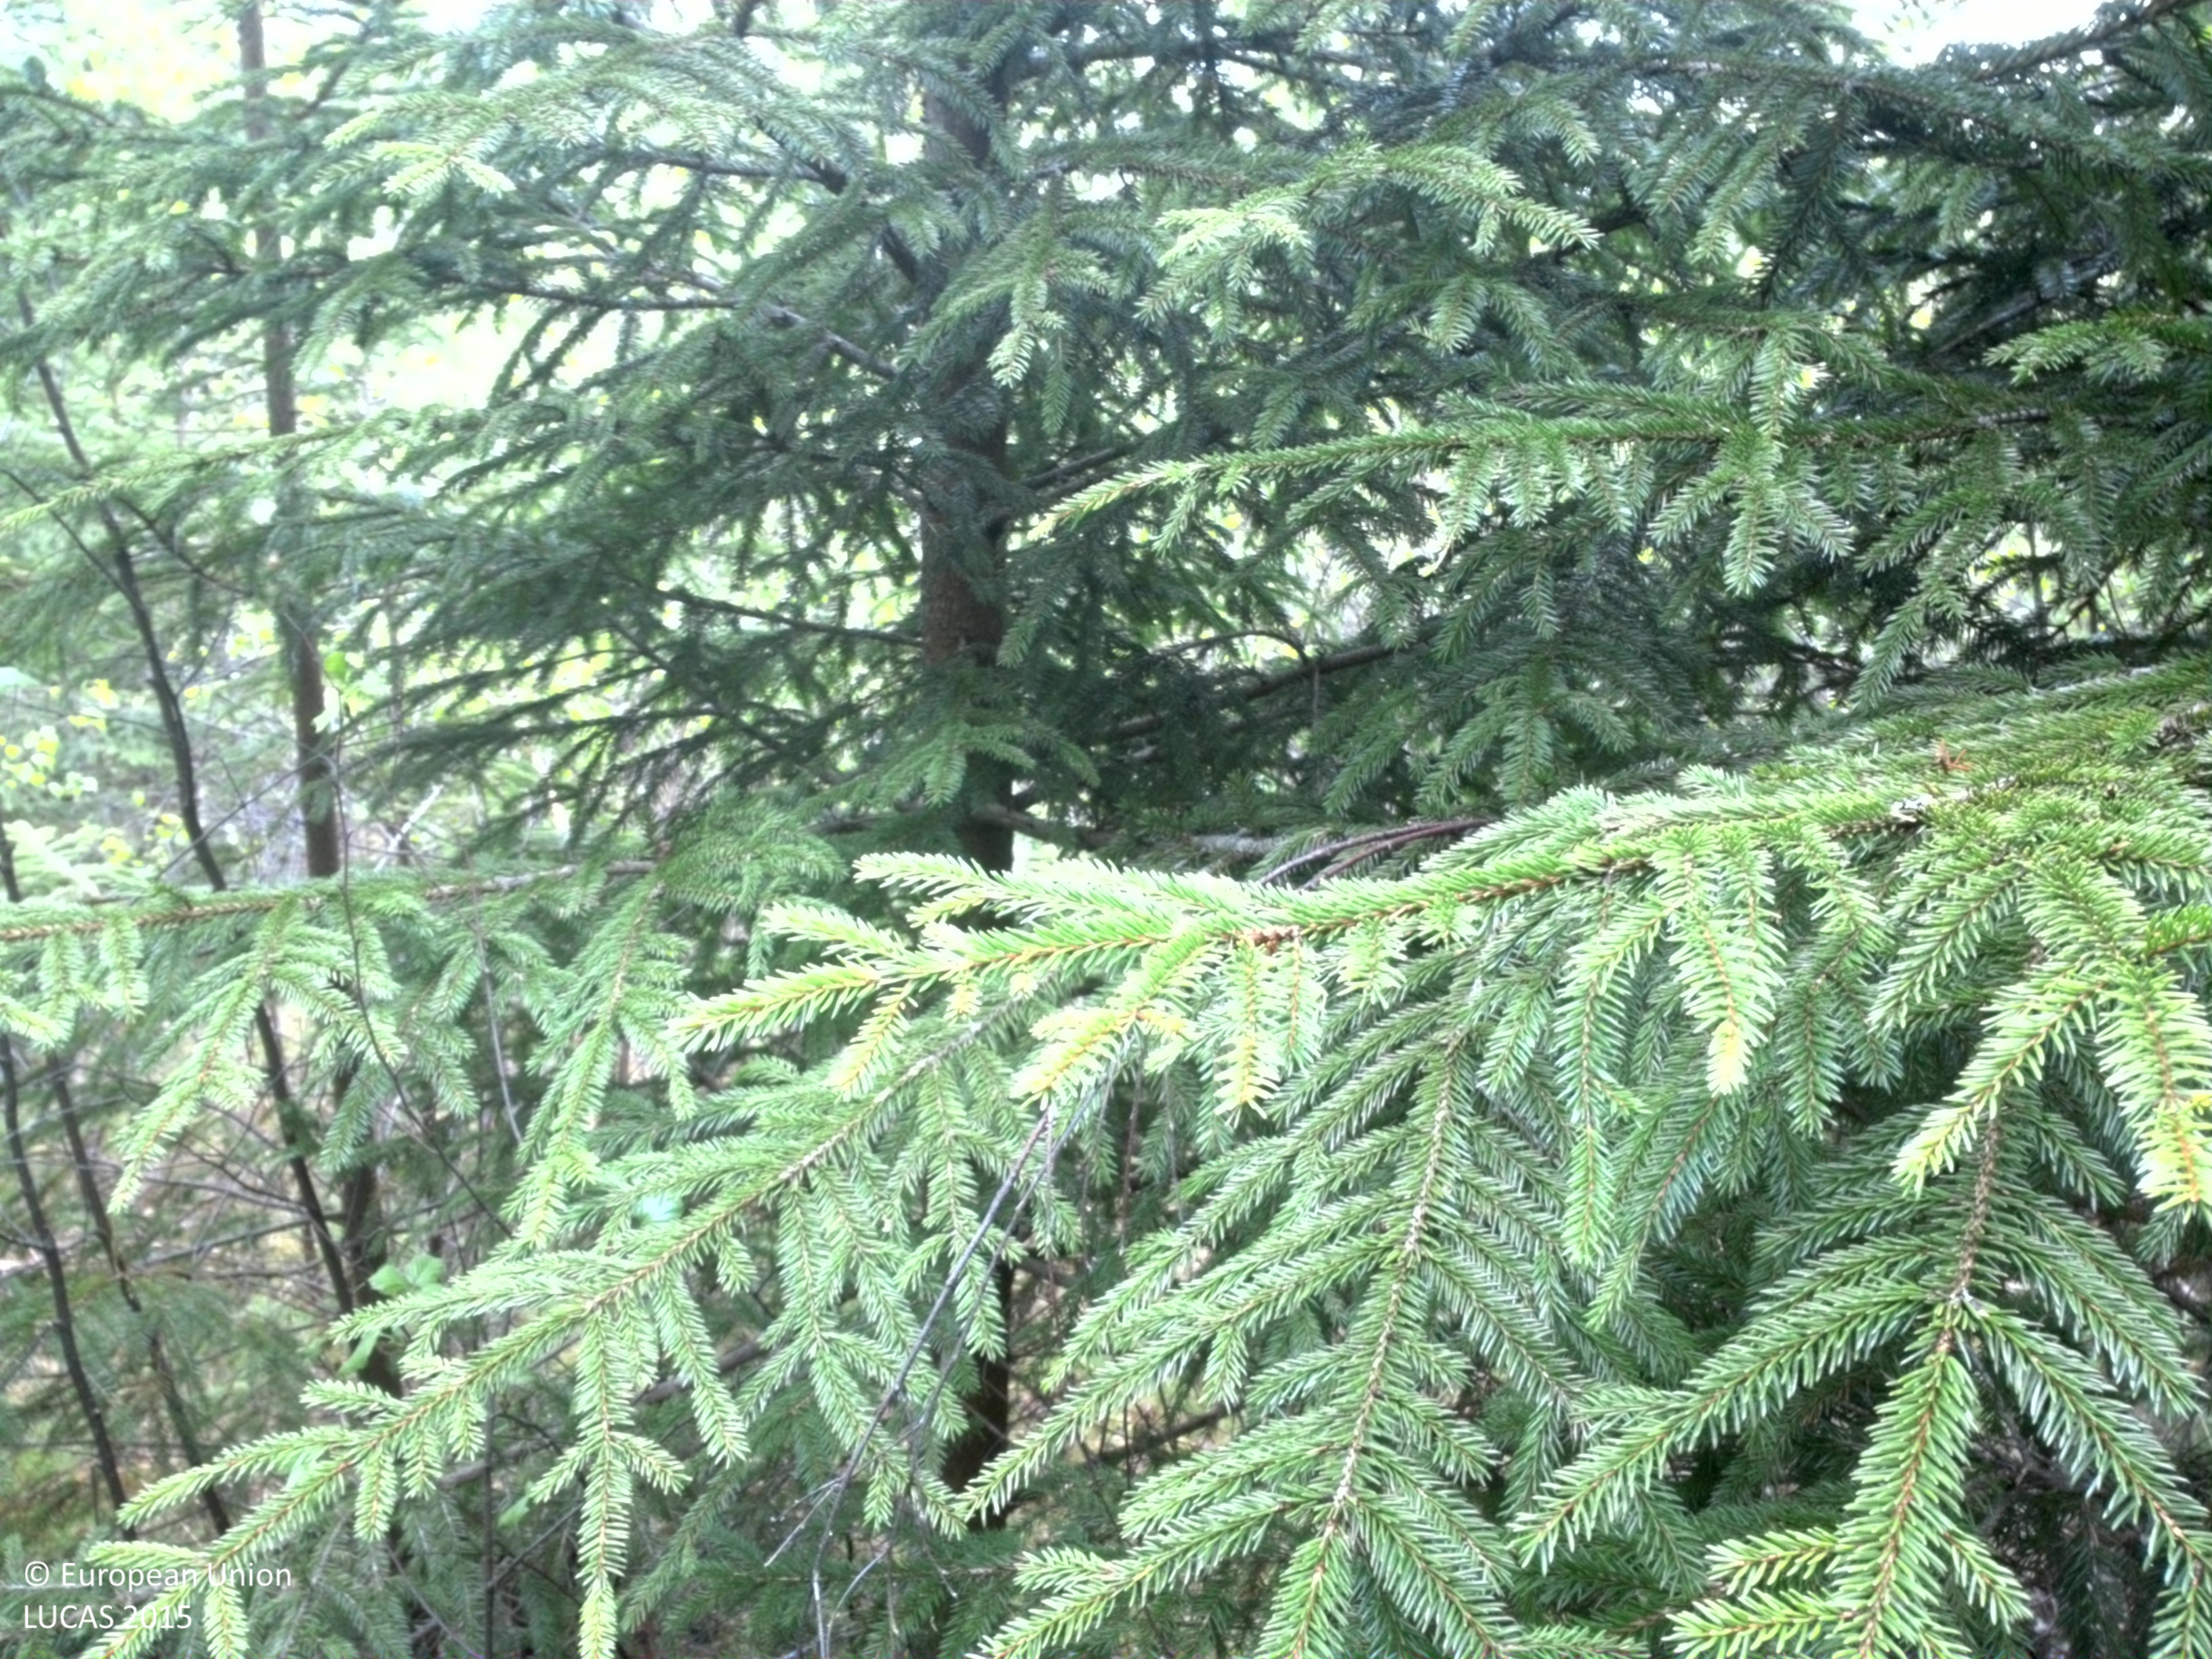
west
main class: Woodland
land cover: Spruce dominated mixed woodland
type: boreal forest
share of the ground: > 75 %
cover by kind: coniferous forest trees 60 %, broadleaved forest trees 20 %, herbaceous plants 10 %, lichens and mosses 10 %
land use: Forestry
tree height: < 5 m
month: May
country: SE
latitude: 56.5898
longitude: 15.1276
